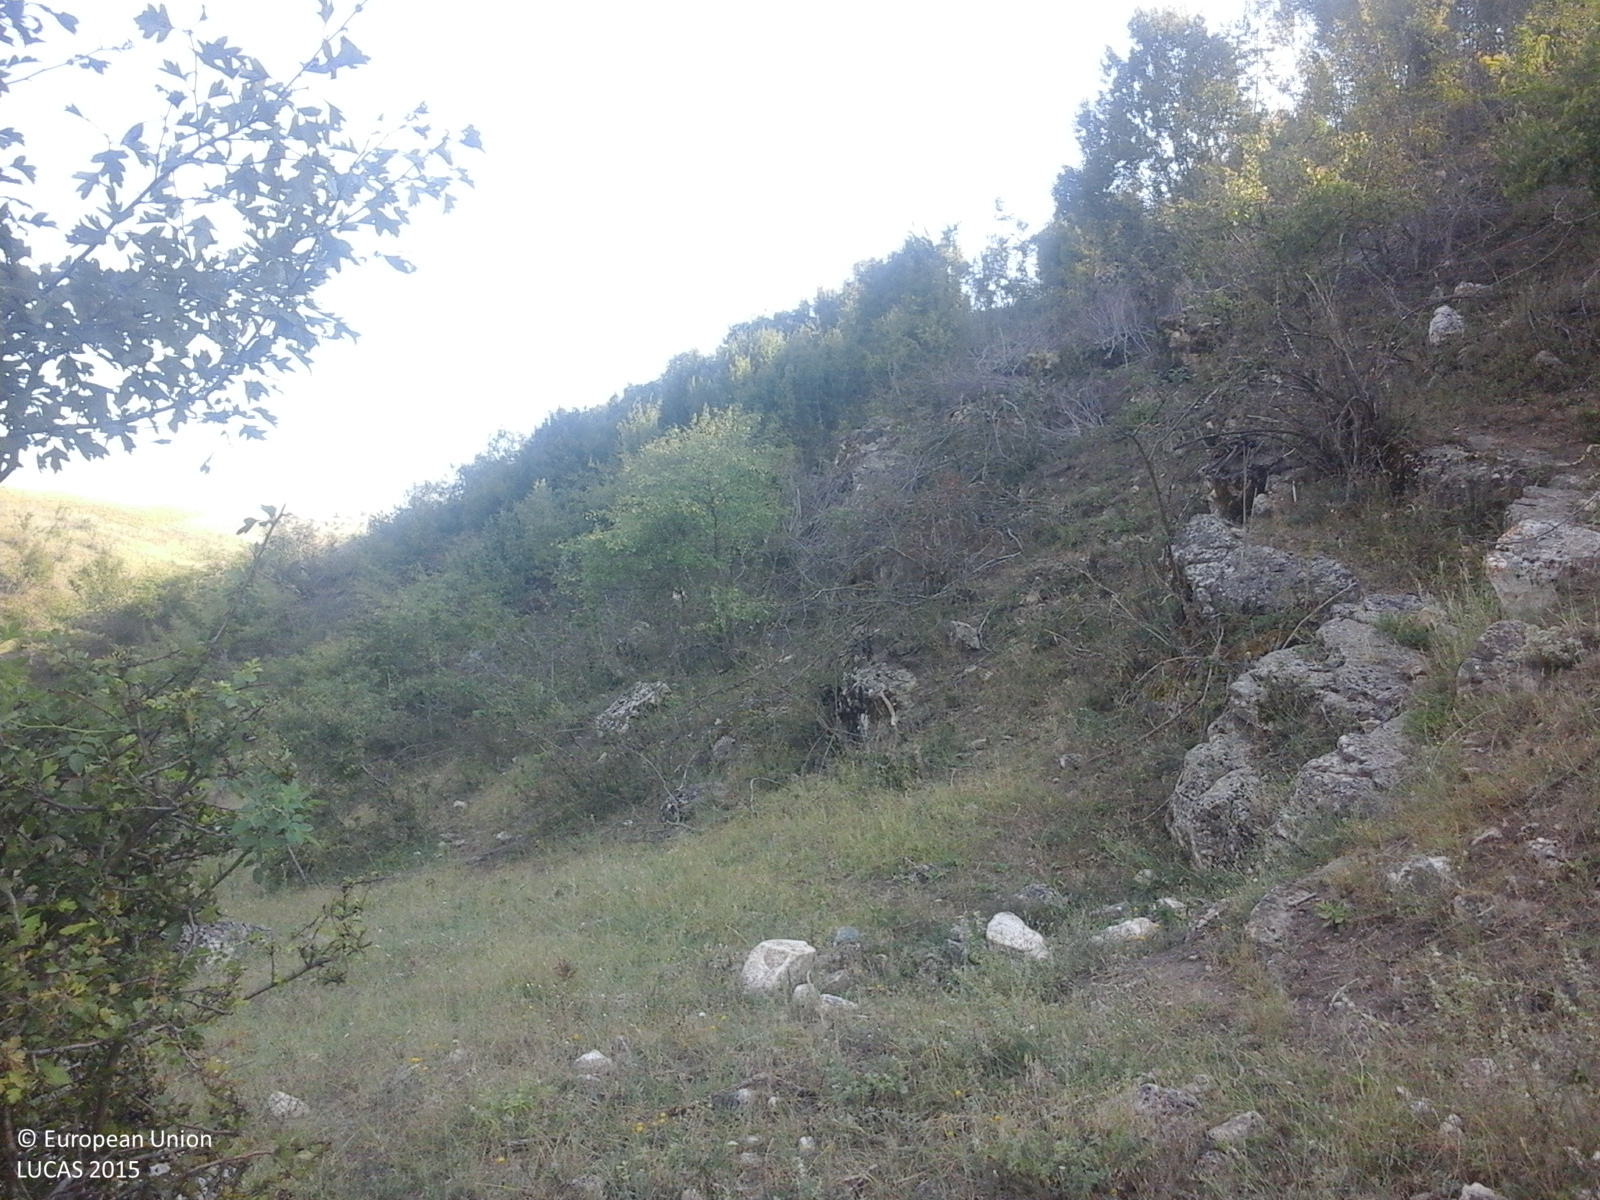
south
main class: Grassland
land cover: Grassland with sparse tree/shrub cover
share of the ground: > 75 %
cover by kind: herbaceous plants 95 %, broadleaved forest trees 5 %
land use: Semi-natural and natural areas not in use
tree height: < 5 m
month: August
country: RO
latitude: 44.1191
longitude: 28.0361
